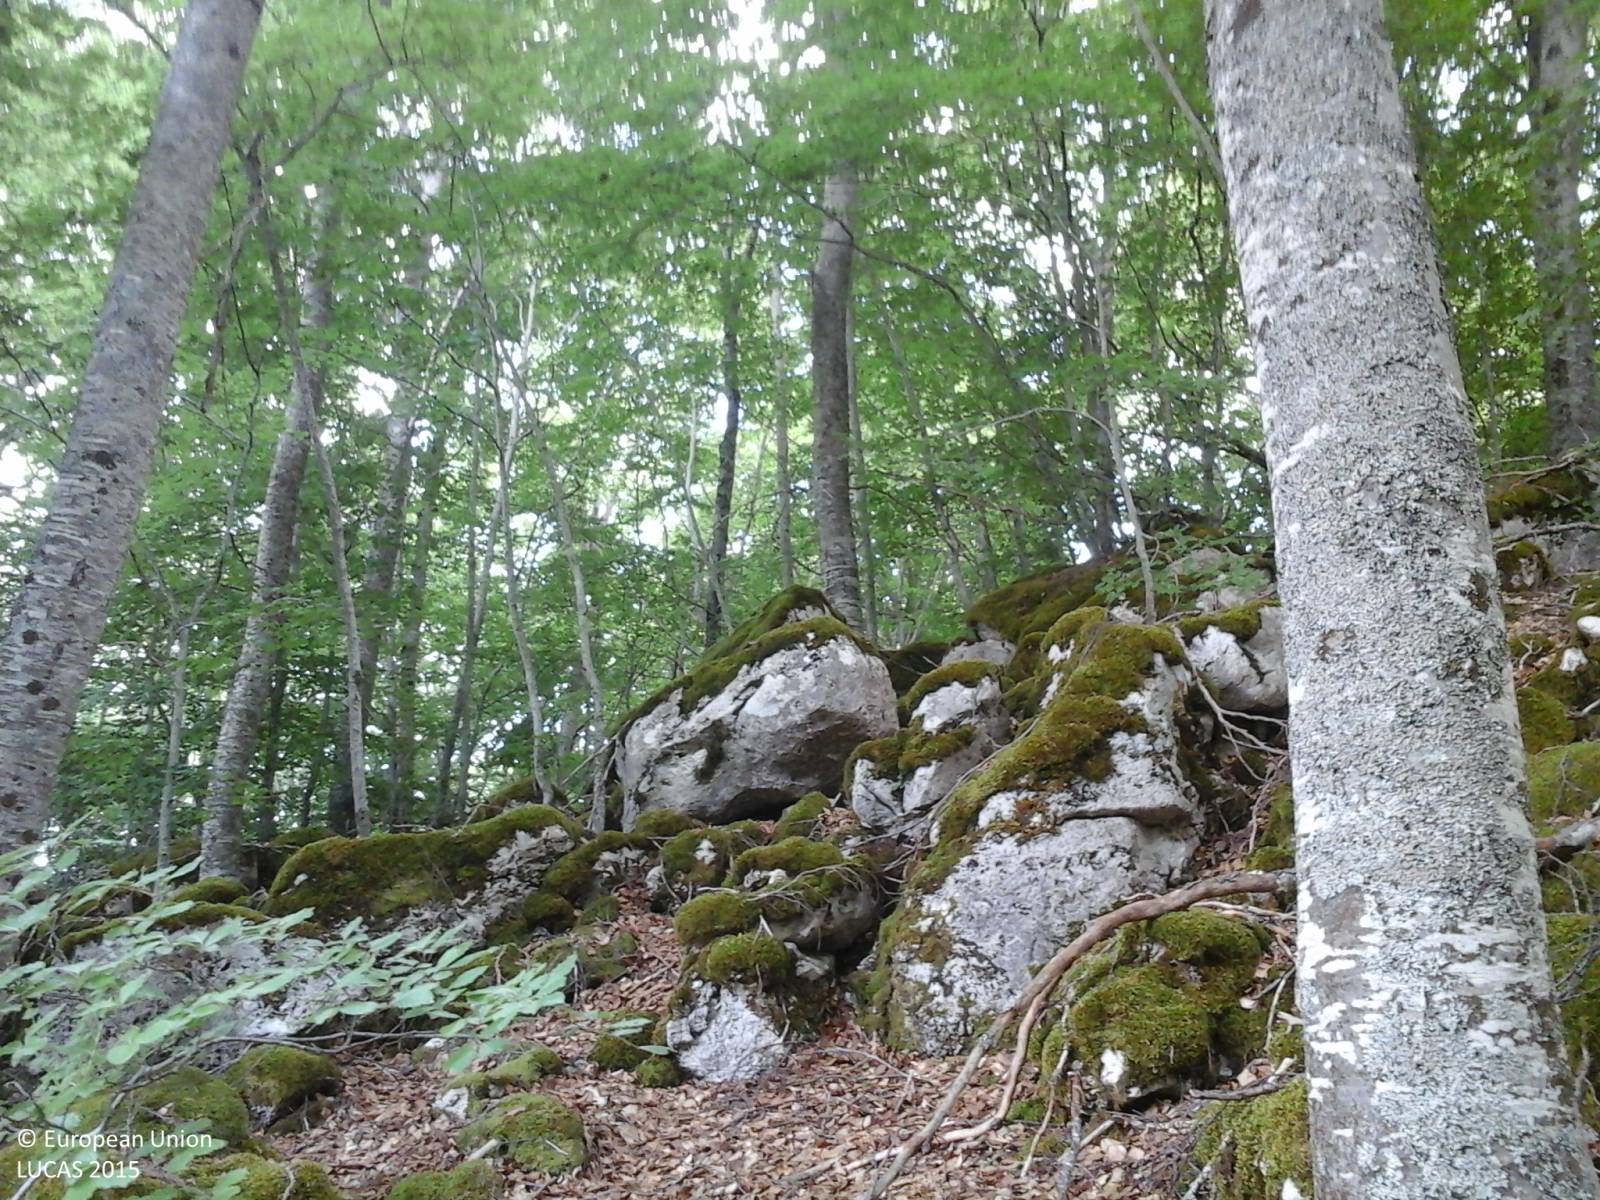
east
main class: Woodland
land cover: Broadleaved woodland
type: mountainous beech forest
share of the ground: > 75 %
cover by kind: broadleaved forest trees 100 %
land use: Forestry
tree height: > 5 m
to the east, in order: Broadleaved woodland
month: June
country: IT
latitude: 41.8697
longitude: 13.9983
